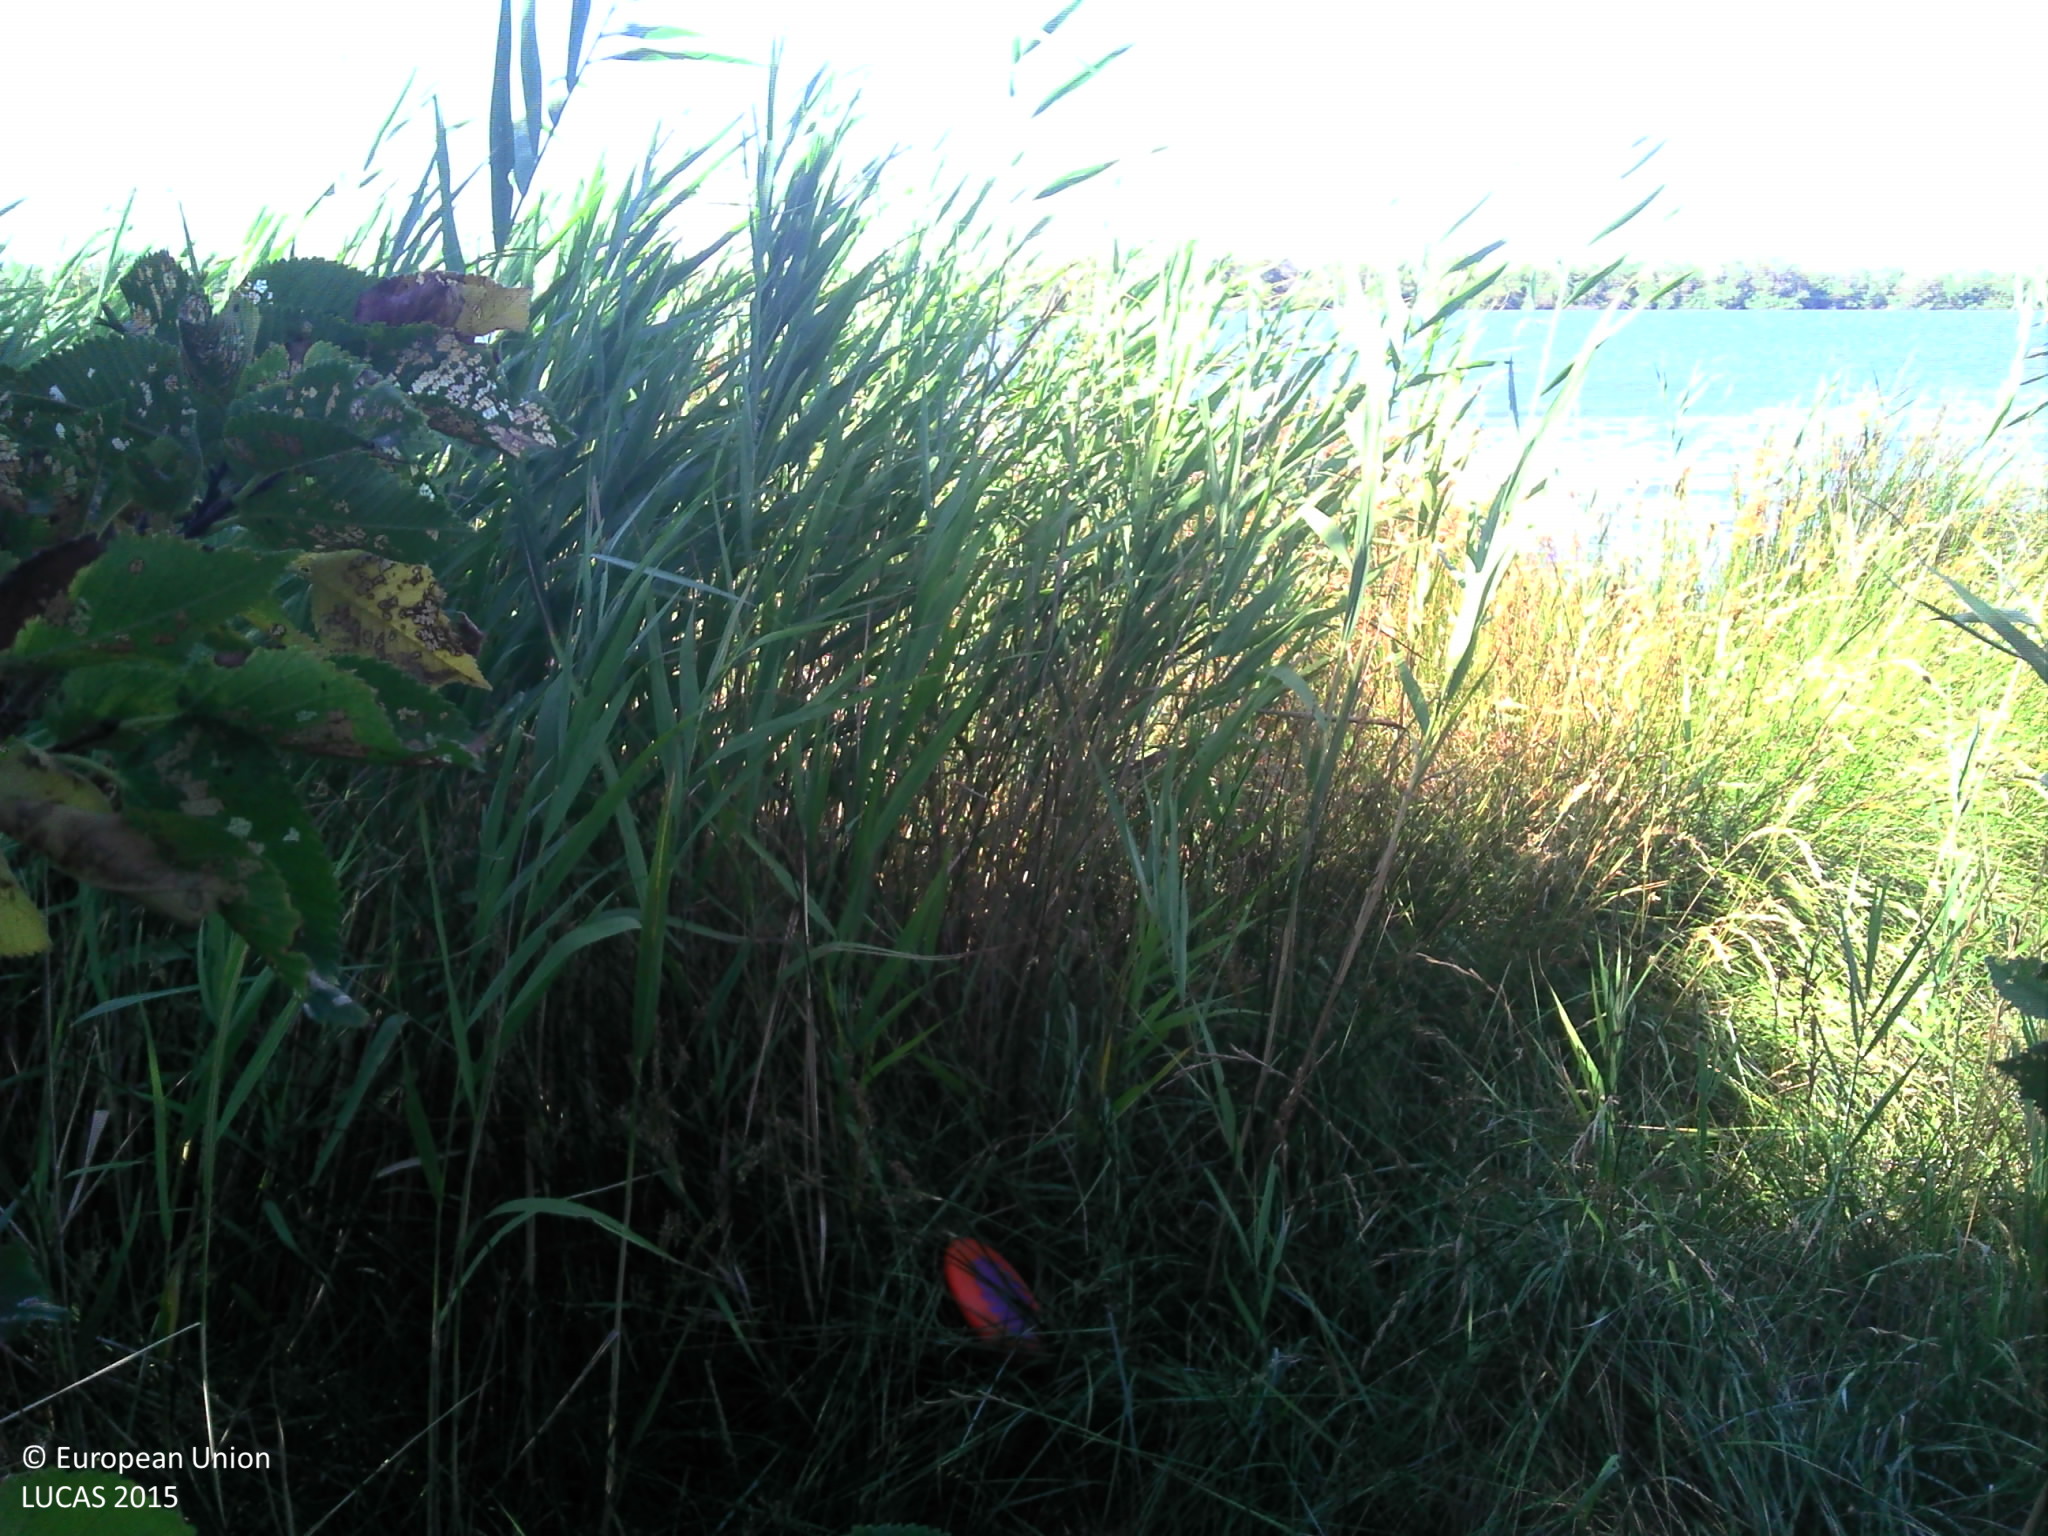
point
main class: Grassland
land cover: Spontaneously vegetated surfaces
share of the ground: 50 - 75 %
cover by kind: herbaceous plants 50 %, shrubs 5 %
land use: Semi-natural and natural areas not in use
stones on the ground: < 10 %
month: July
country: FR
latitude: 43.3881
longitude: 4.7886
